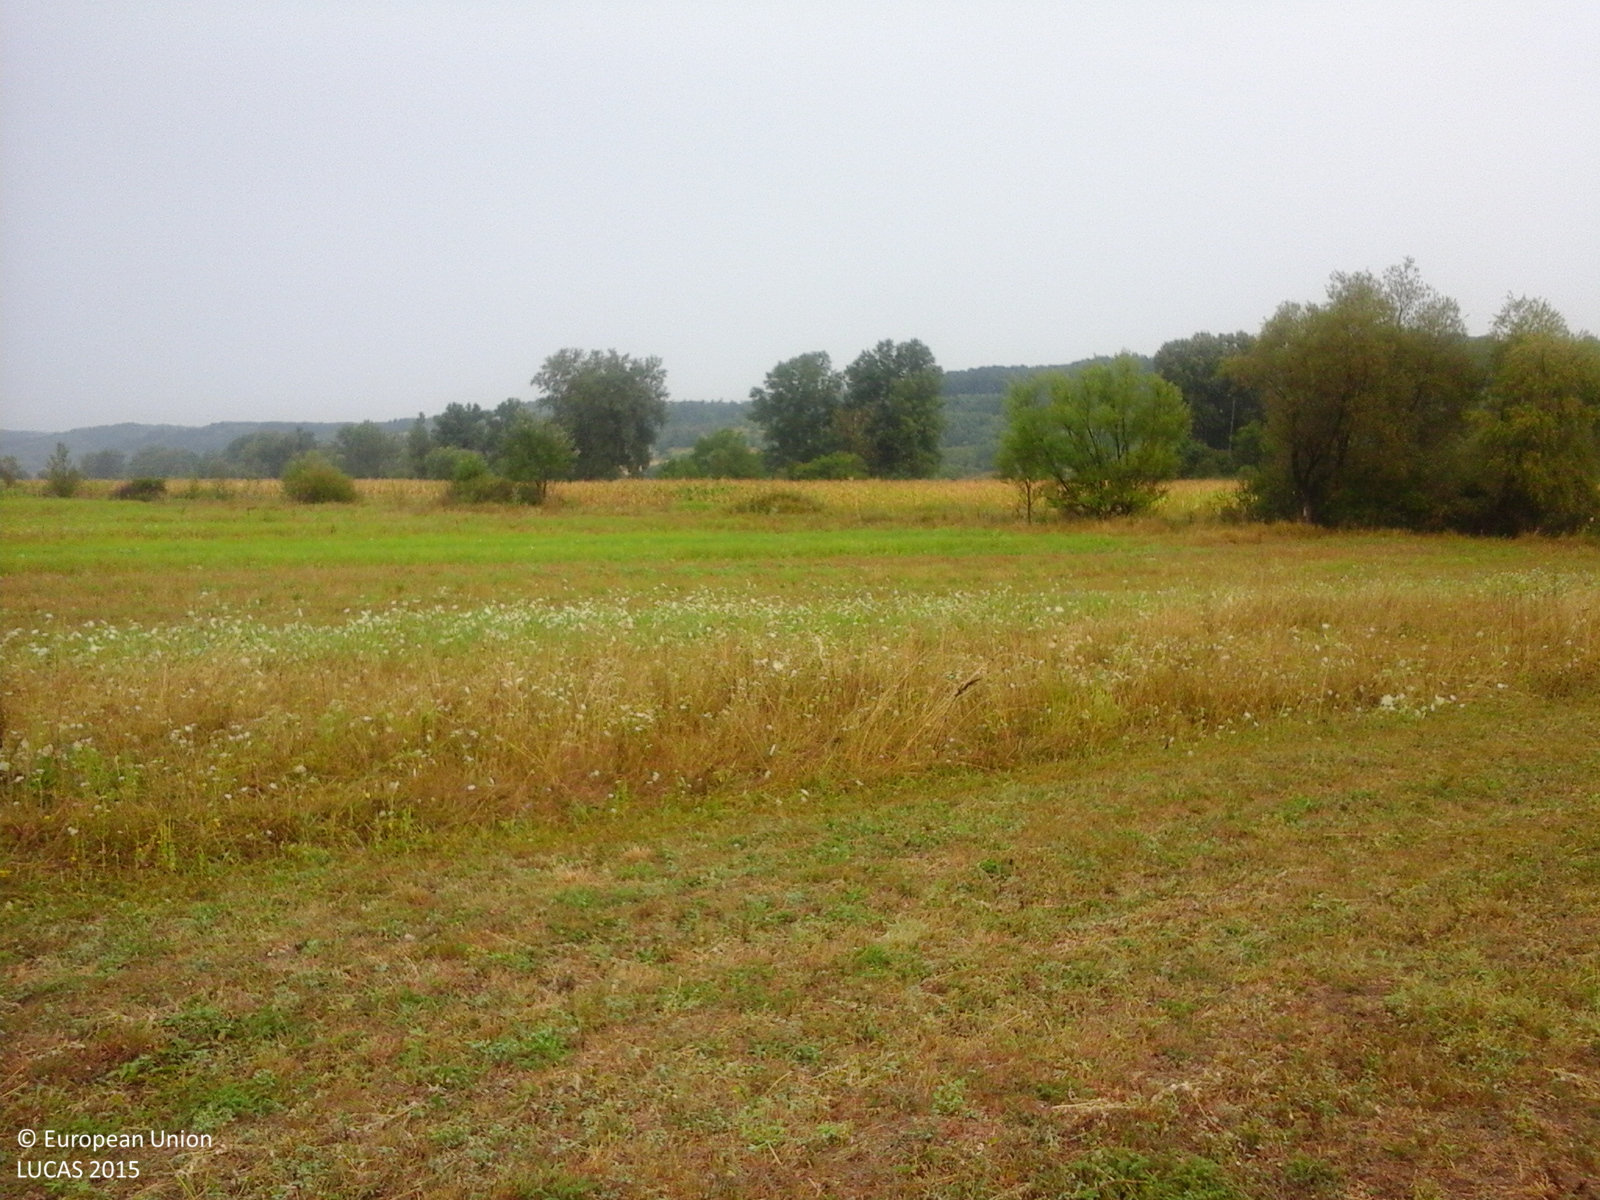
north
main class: Cropland
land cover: Lucerne
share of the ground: > 75 %
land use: Agriculture (excluding fallow land and kitchen gardens)
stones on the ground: < 10 %
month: August
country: RO
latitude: 44.7291
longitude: 22.8867
